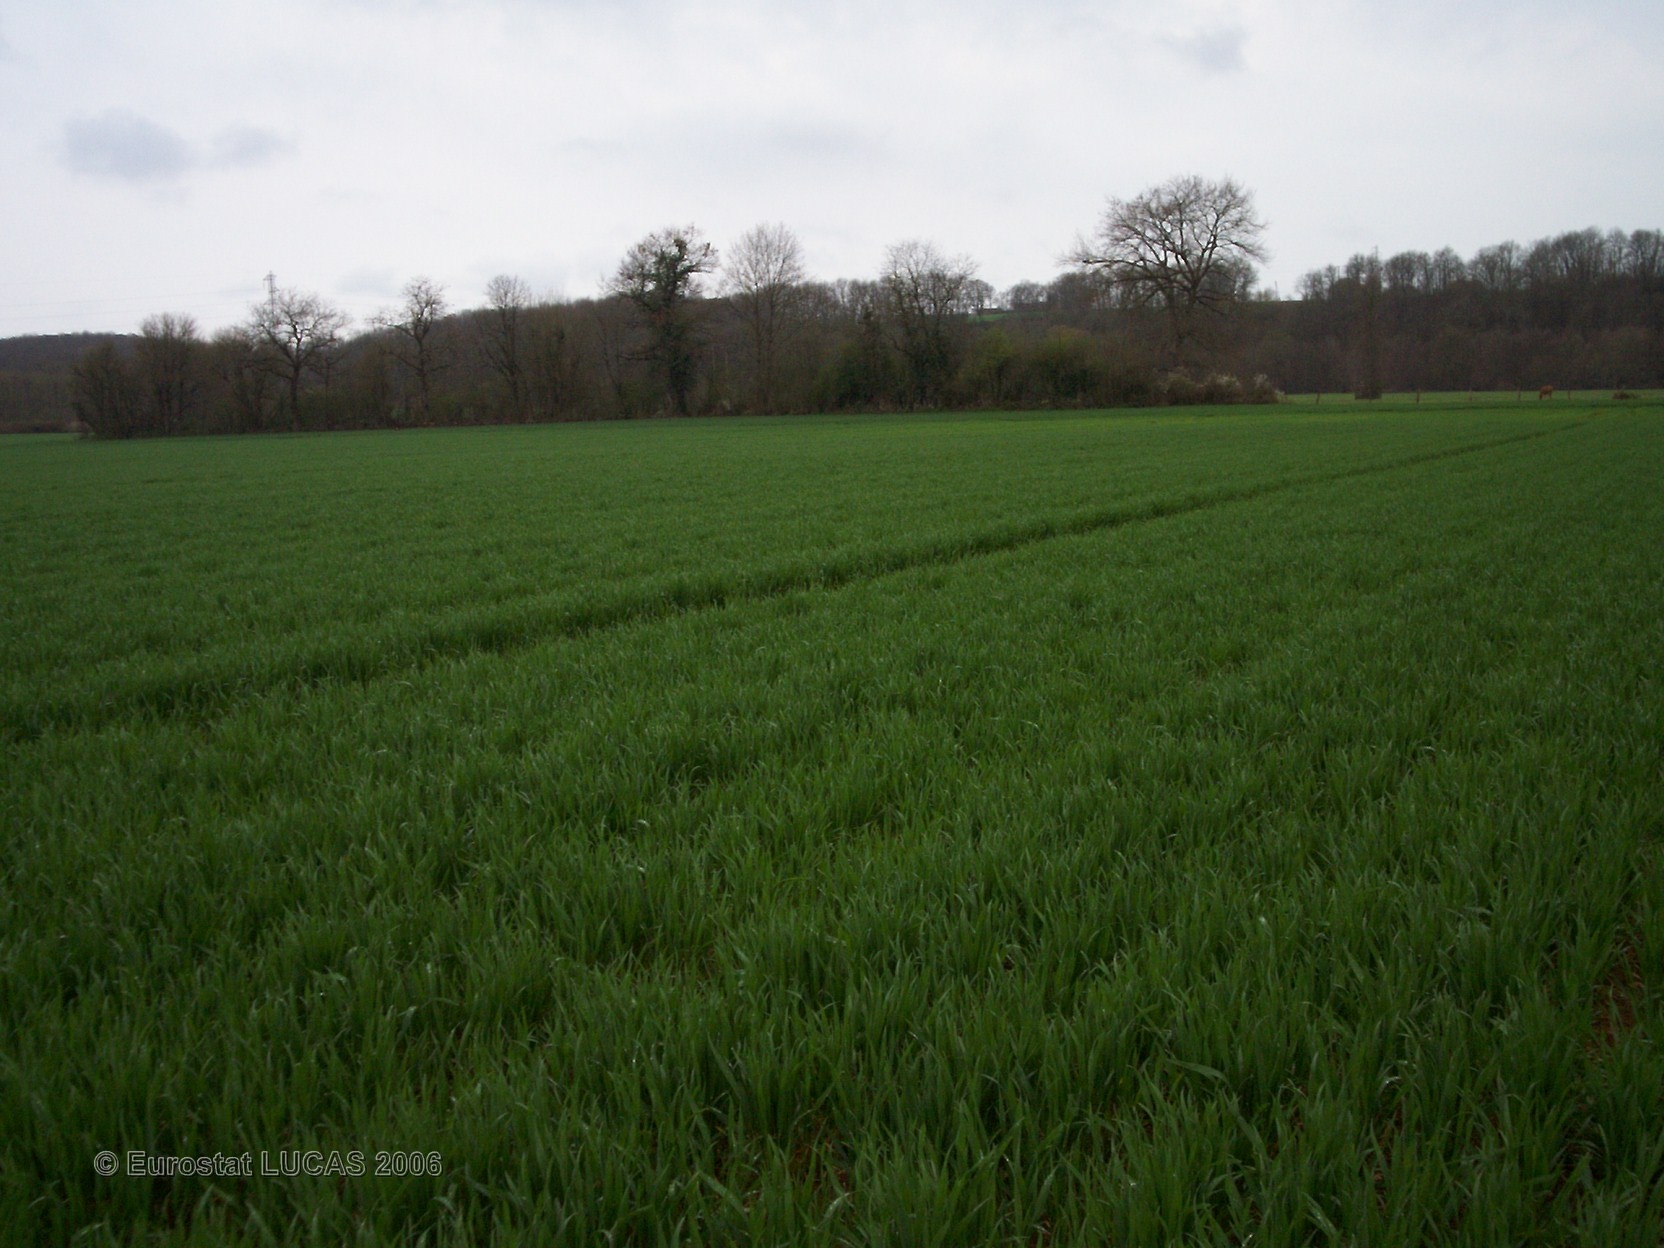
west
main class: Cropland
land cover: Common wheat
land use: Agriculture (excluding fallow land and kitchen gardens)
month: April
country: FR
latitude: 46.5574
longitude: 1.0777
